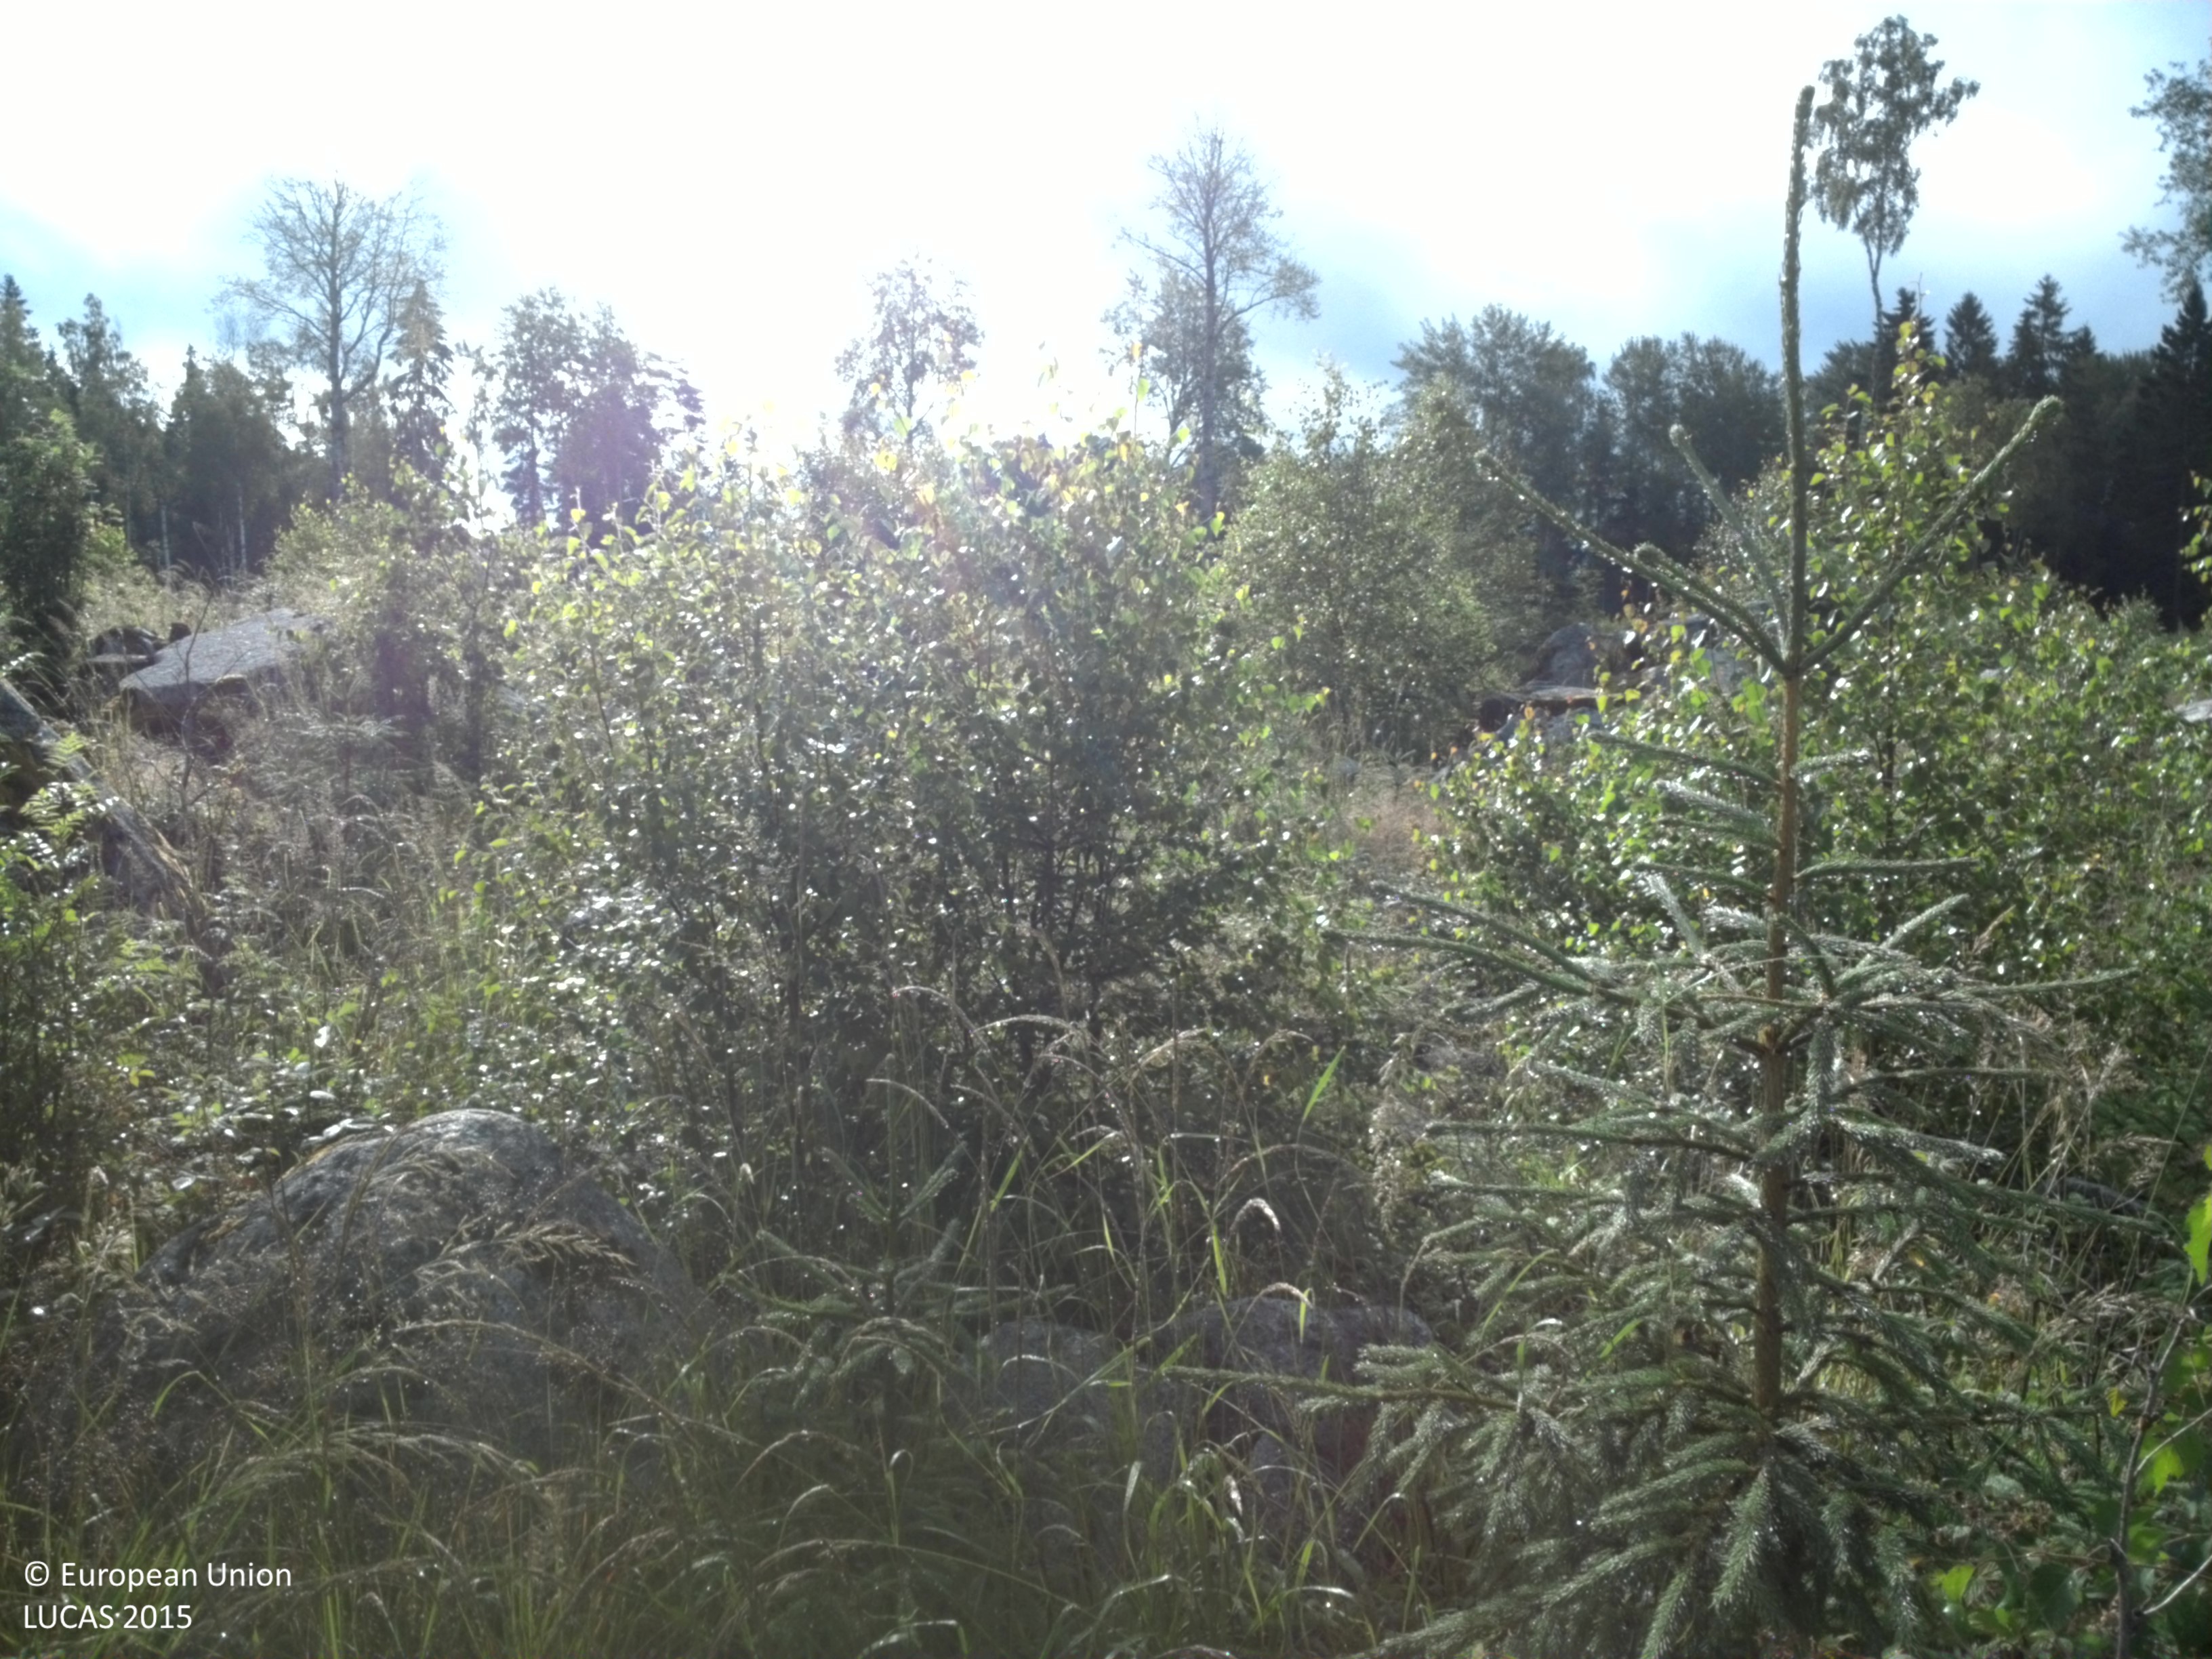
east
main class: Woodland
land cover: Broadleaved woodland
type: boreal forest
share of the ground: 25 - 50 %
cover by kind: herbaceous plants 50 %, broadleaved forest trees 40 %, coniferous forest trees 10 %
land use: Forestry
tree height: < 5 m
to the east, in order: Broadleaved woodland; Spruce dominated coniferous woodland; Broadleaved woodland; Ditches and canals; Grassland without tree/shrub cover; Ditches and canals; Inland marshes
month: July
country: SE
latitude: 60.0656
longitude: 17.2683
